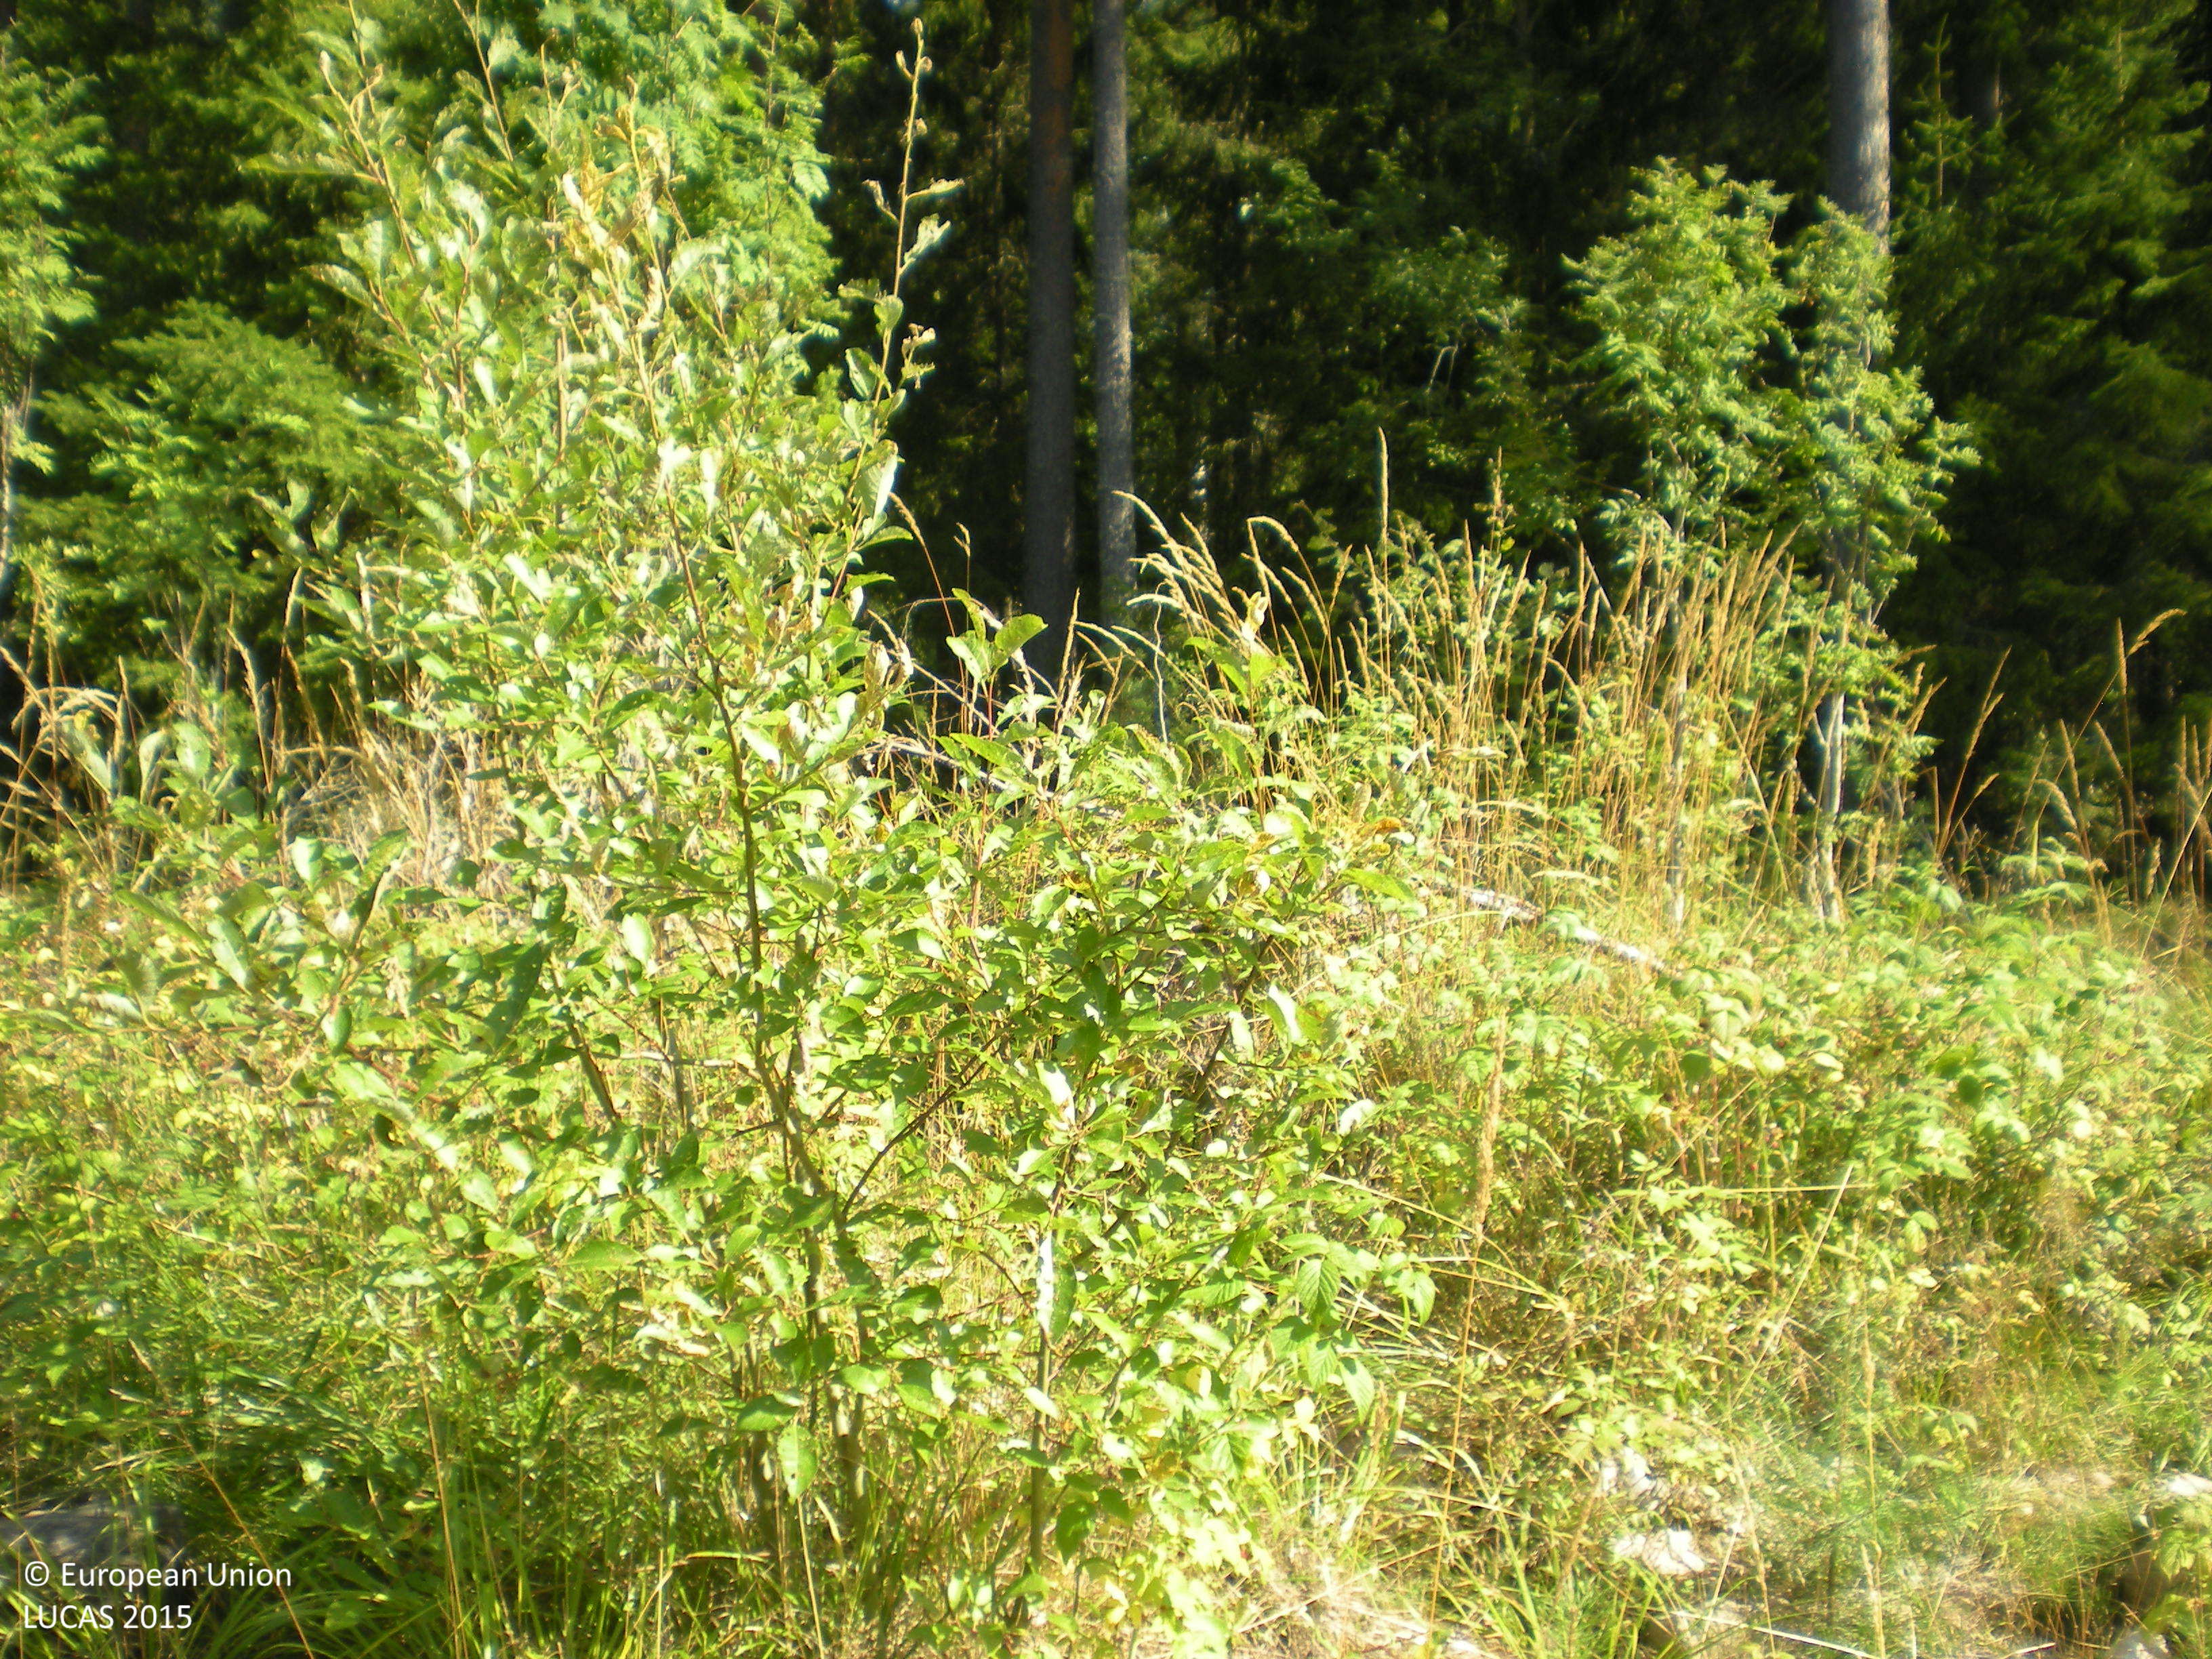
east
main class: Shrubland
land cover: Shrubland with sparse tree cover
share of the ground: 50 - 75 %
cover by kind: shrubs 60 %, unconsolidated bare surface 15 %, herbaceous plants 10 %, consolidated bare surface 10 %, broadleaved forest trees 5 %
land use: Forestry
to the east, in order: Shrubland with sparse tree cover; Broadleaved woodland; Other coniferous woodland; Spruce dominated coniferous woodland; Broadleaved woodland; Grassland with sparse tree/shrub cover; Paved roads, cycling and walking lanes; Grass margins; Ditches and canals; Spruce dominated mixed woodland; Rivers and streams; Spruce dominated mixed woodland; Spruce dominated coniferous woodland; Ditches and canals; Grass margins; Paved roads, cycling and walking lanes; Grass margins; Ditches and canals; Grassland with sparse tree/shrub cover; Pine dominated mixed woodland
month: August
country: SE
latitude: 60.6257
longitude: 17.2819
